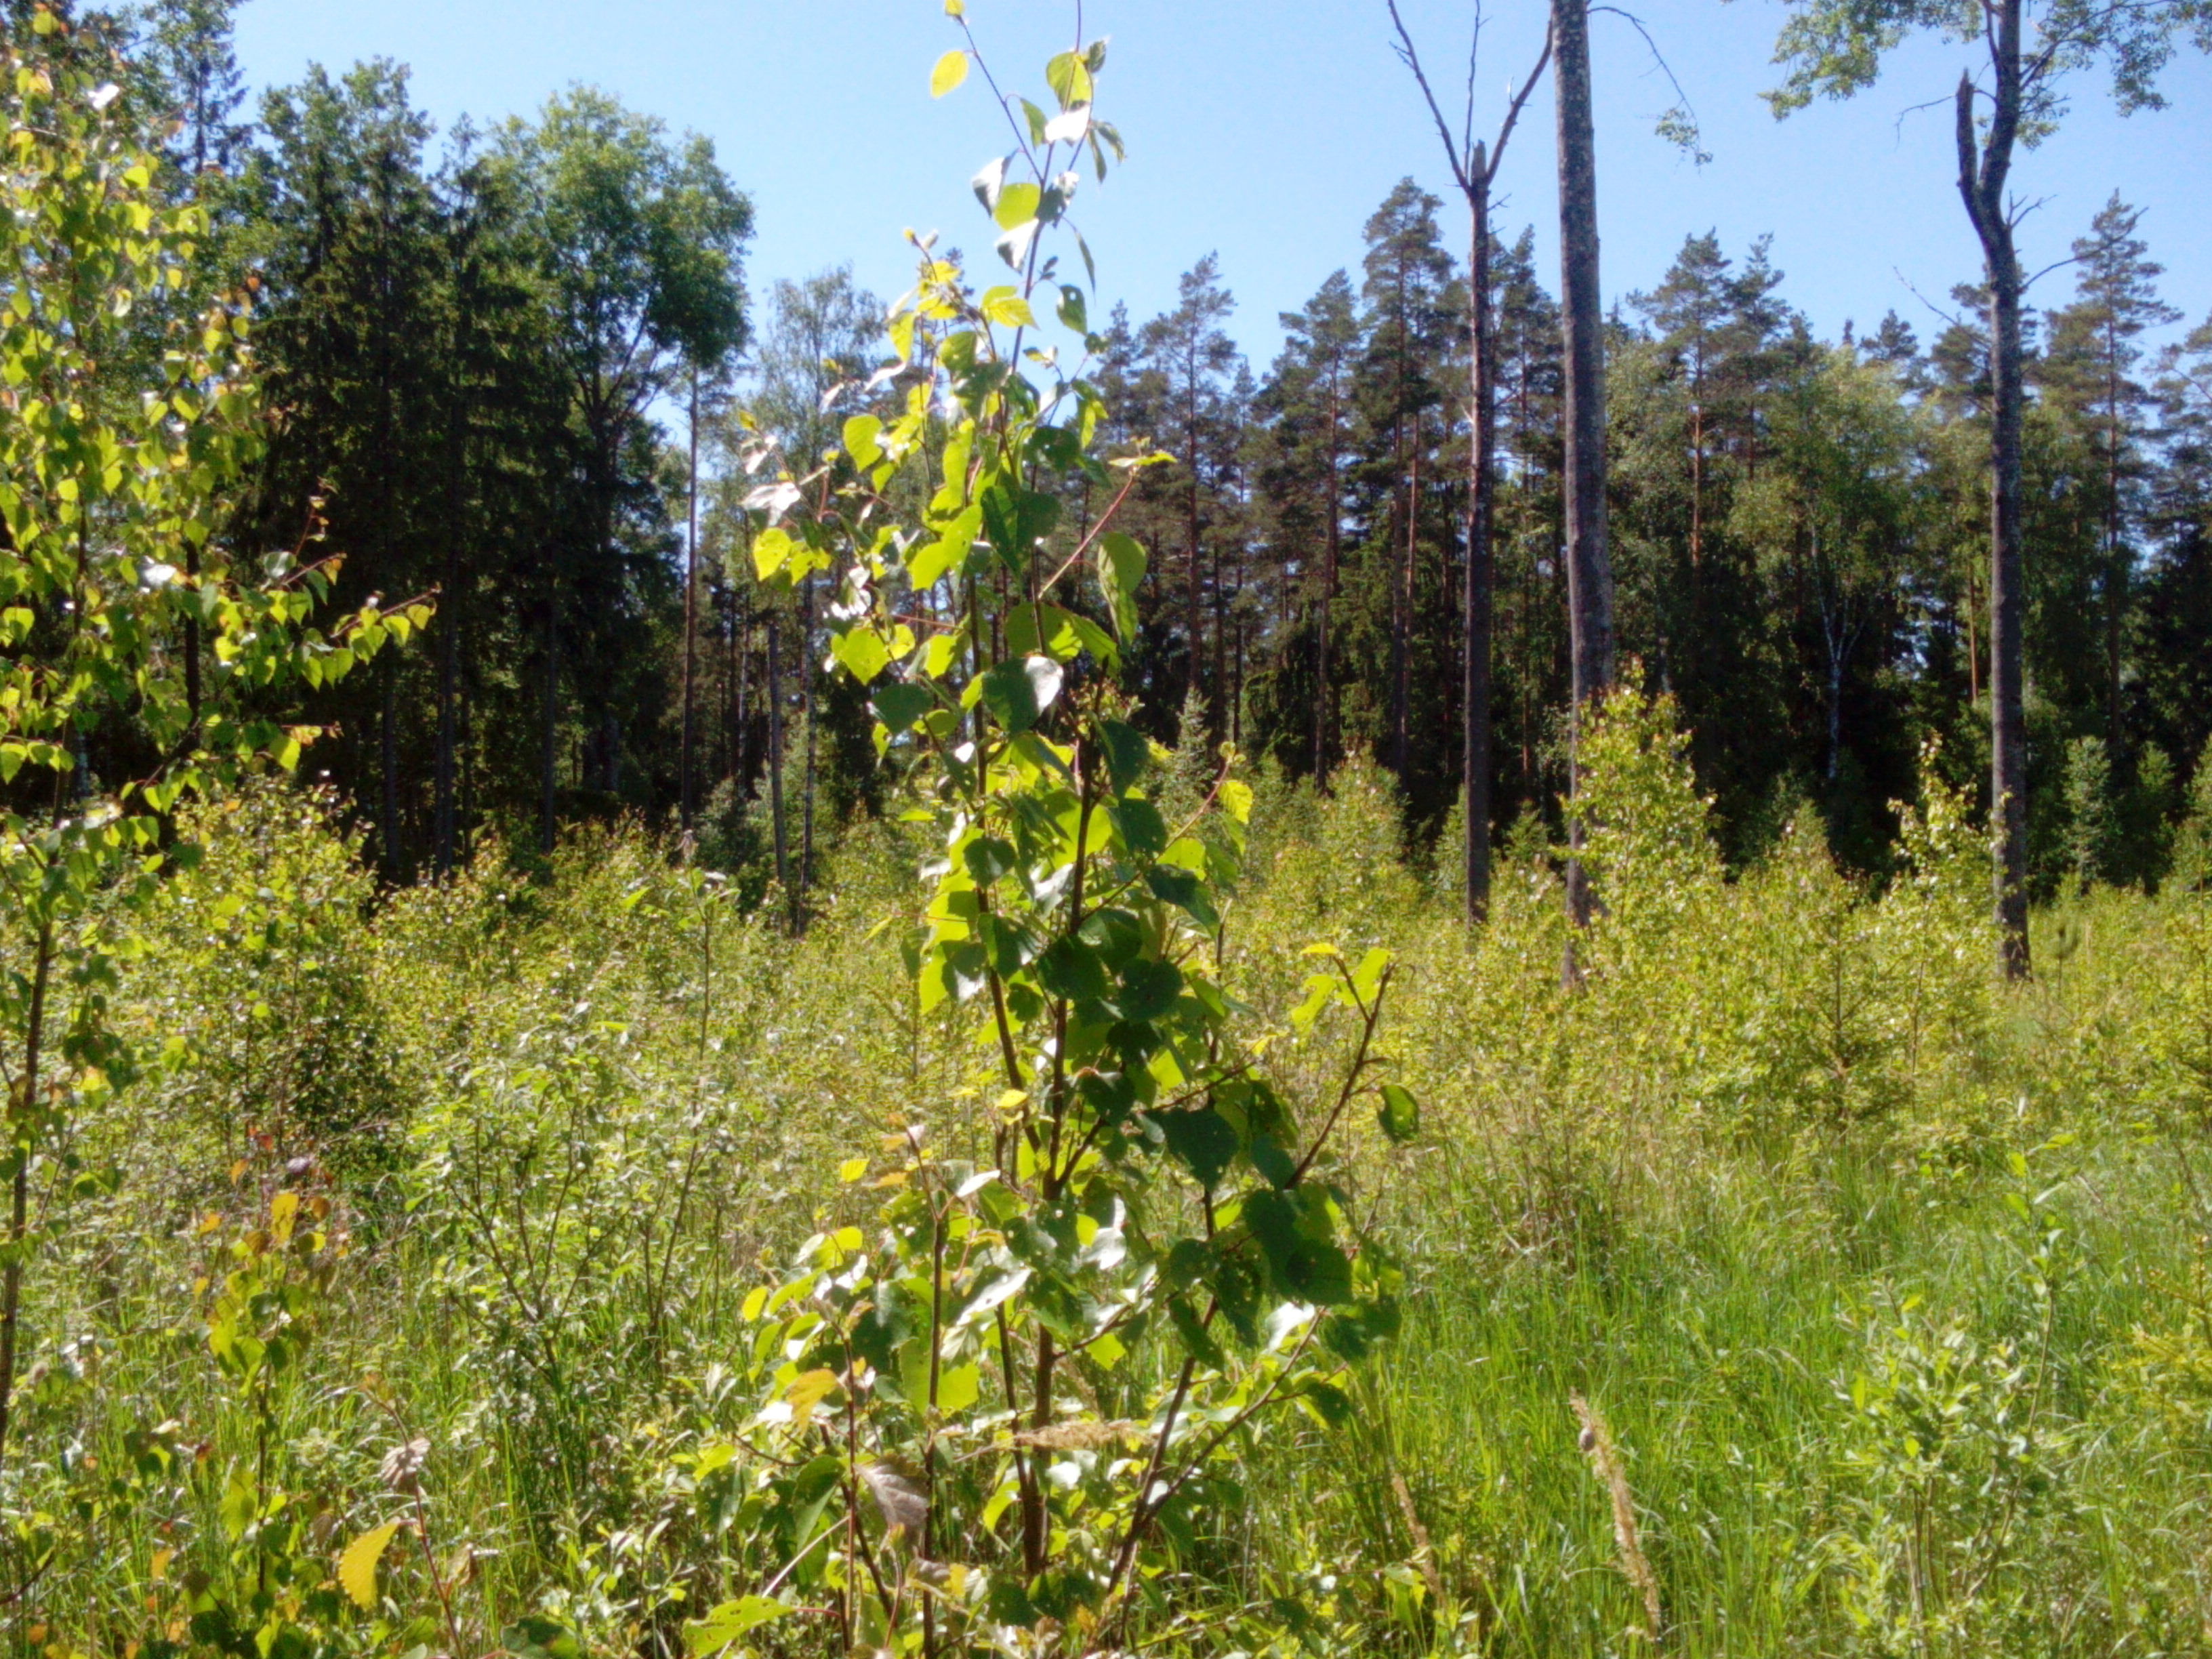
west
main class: Woodland
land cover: Broadleaved woodland
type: non-riverine alder, birch or aspen forest
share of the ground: 50 - 75 %
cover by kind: broadleaved forest trees 50 %, herbaceous plants 40 %, coniferous forest trees 5 %, shrubs 5 %
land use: Forestry
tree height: < 5 m
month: June
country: LV
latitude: 56.6202
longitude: 22.2262
